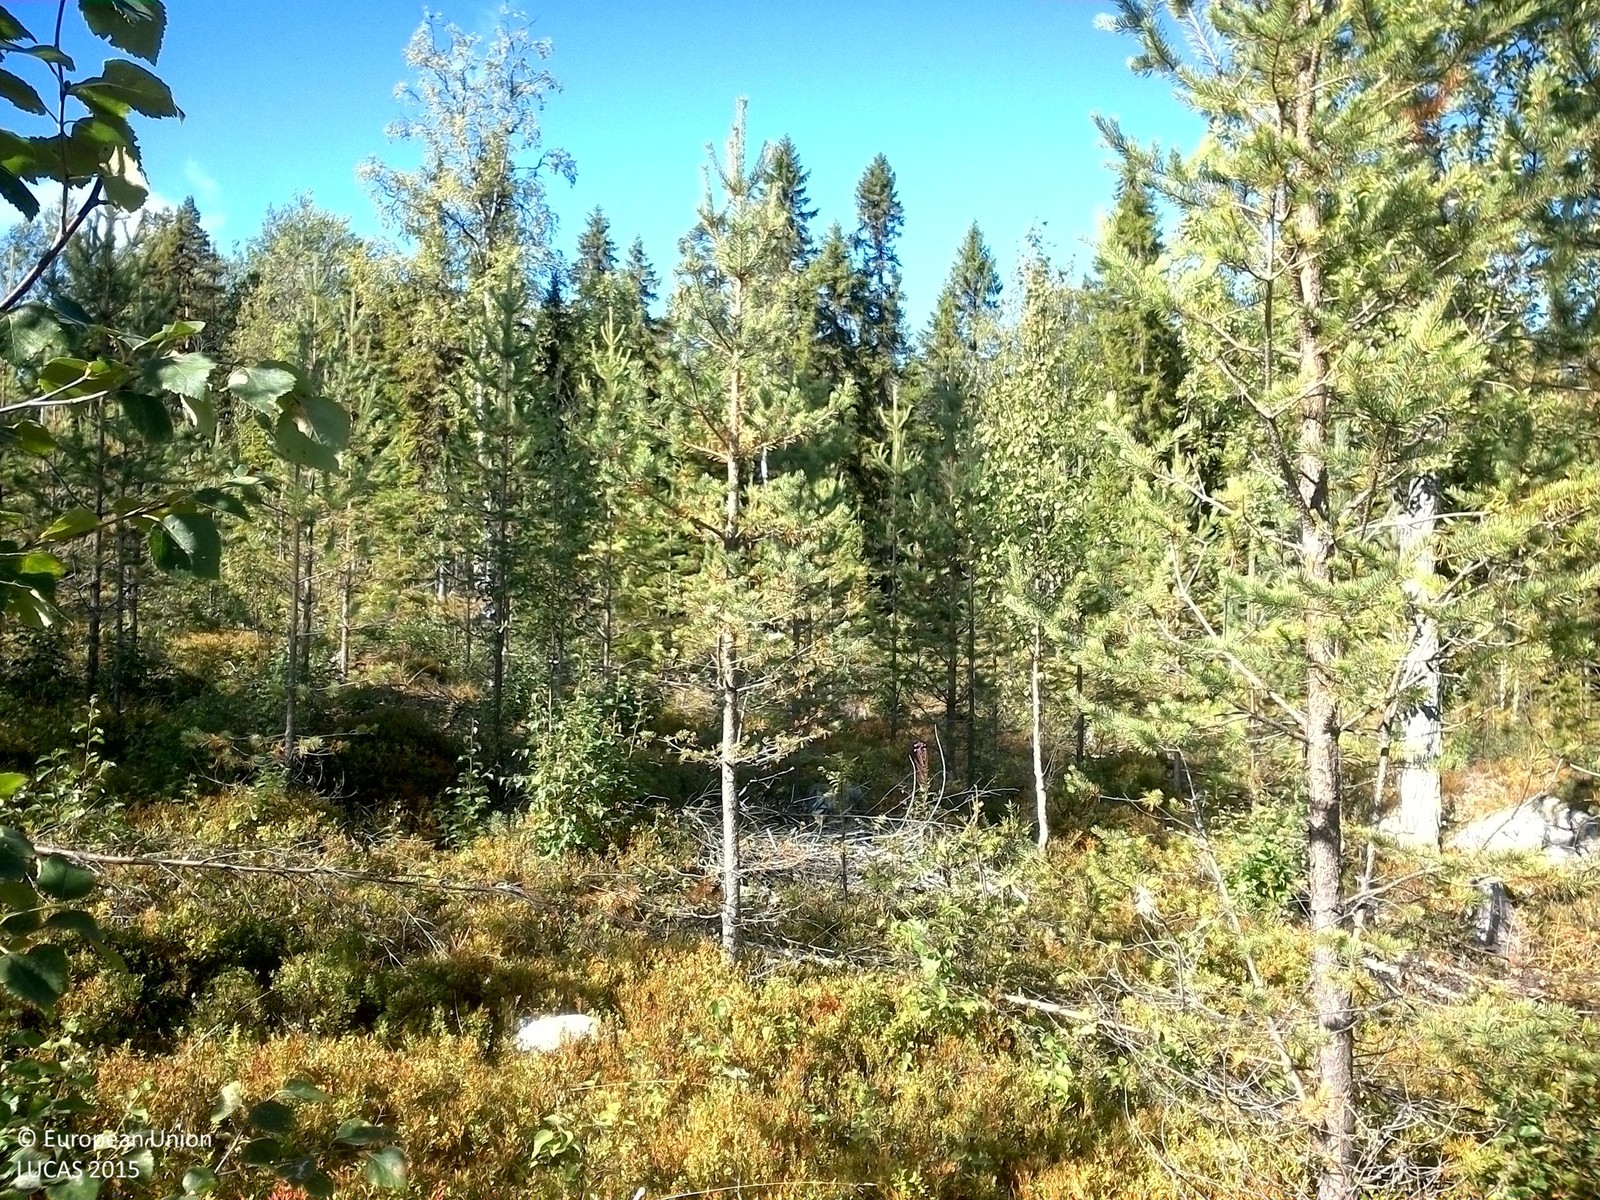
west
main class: Woodland
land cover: Pine dominated mixed woodland
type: boreal forest
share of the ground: 50 - 75 %
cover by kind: coniferous forest trees 40 %, shrubs 25 %, broadleaved forest trees 20 %, lichens and mosses 10 %, herbaceous plants 5 %
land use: Forestry
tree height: < 5 m
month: August
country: SE
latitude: 63.9277
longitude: 17.1698
